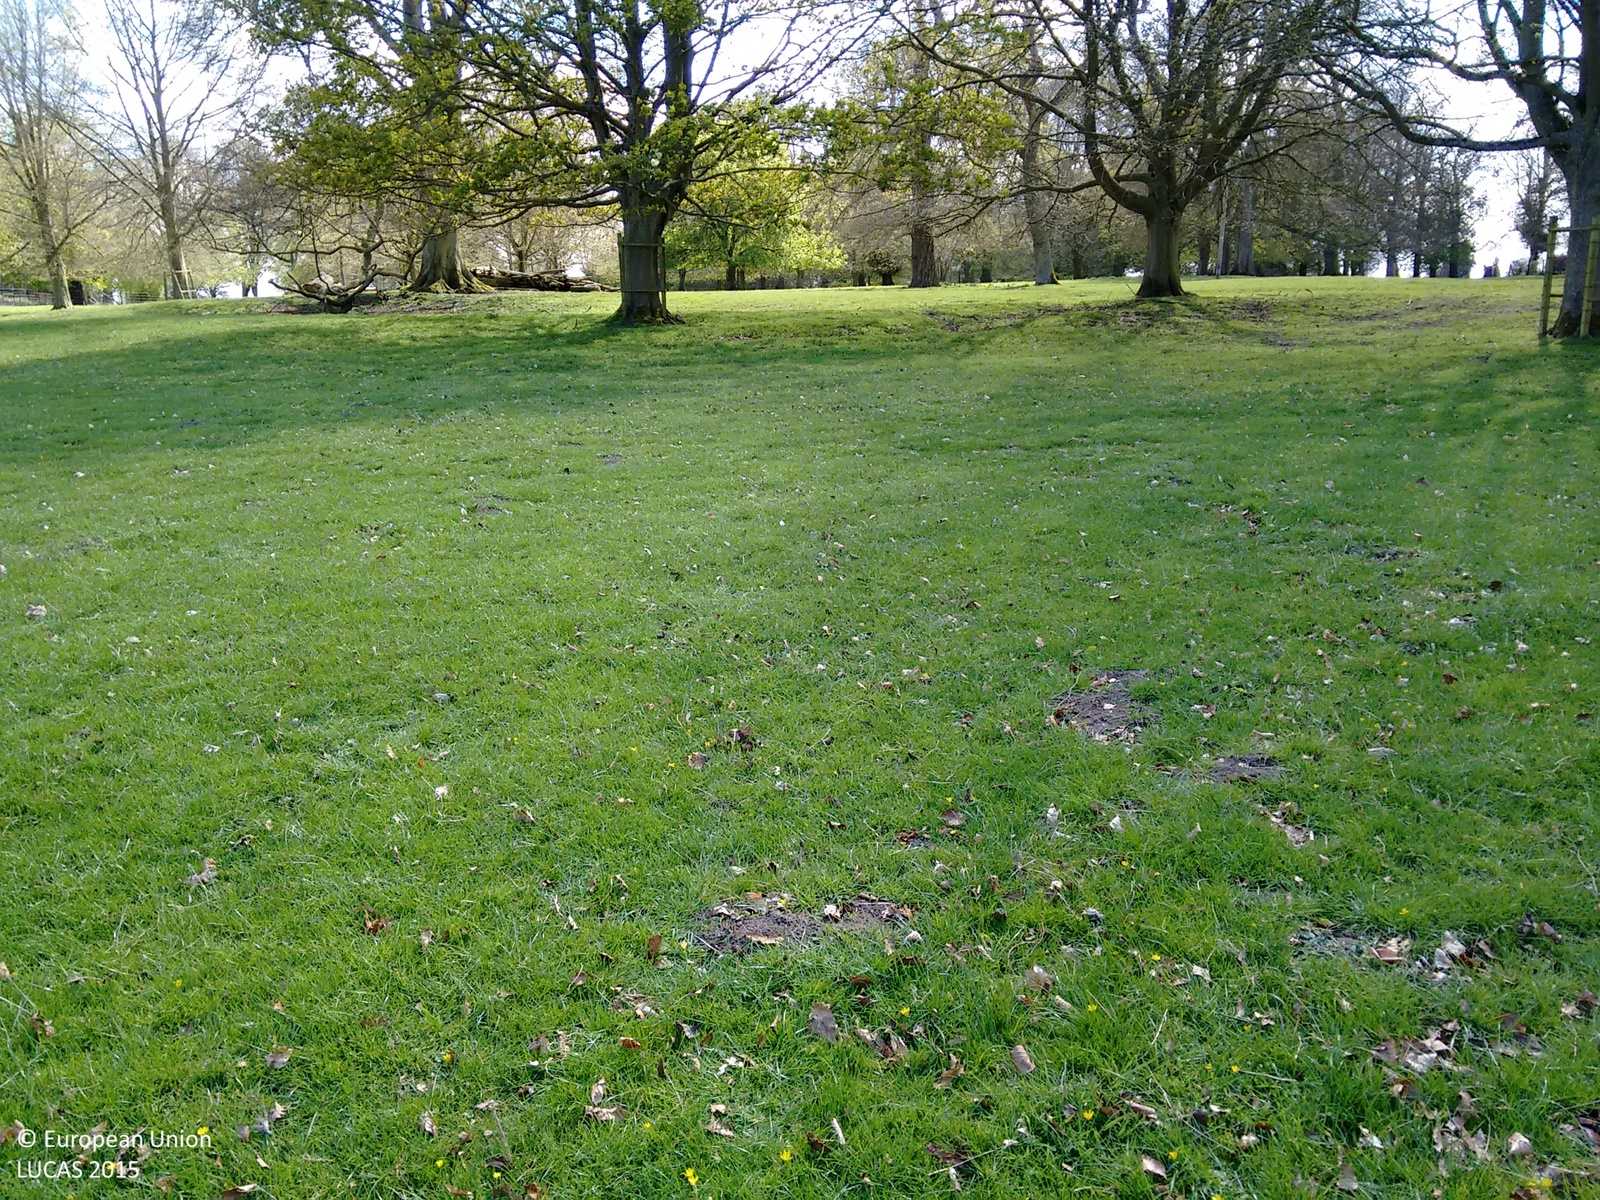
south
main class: Grassland
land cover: Grassland without tree/shrub cover
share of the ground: > 75 %
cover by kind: herbaceous plants 100 %
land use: Agriculture (excluding fallow land and kitchen gardens)
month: April
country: GB
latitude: 53.1777
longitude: -0.1027
